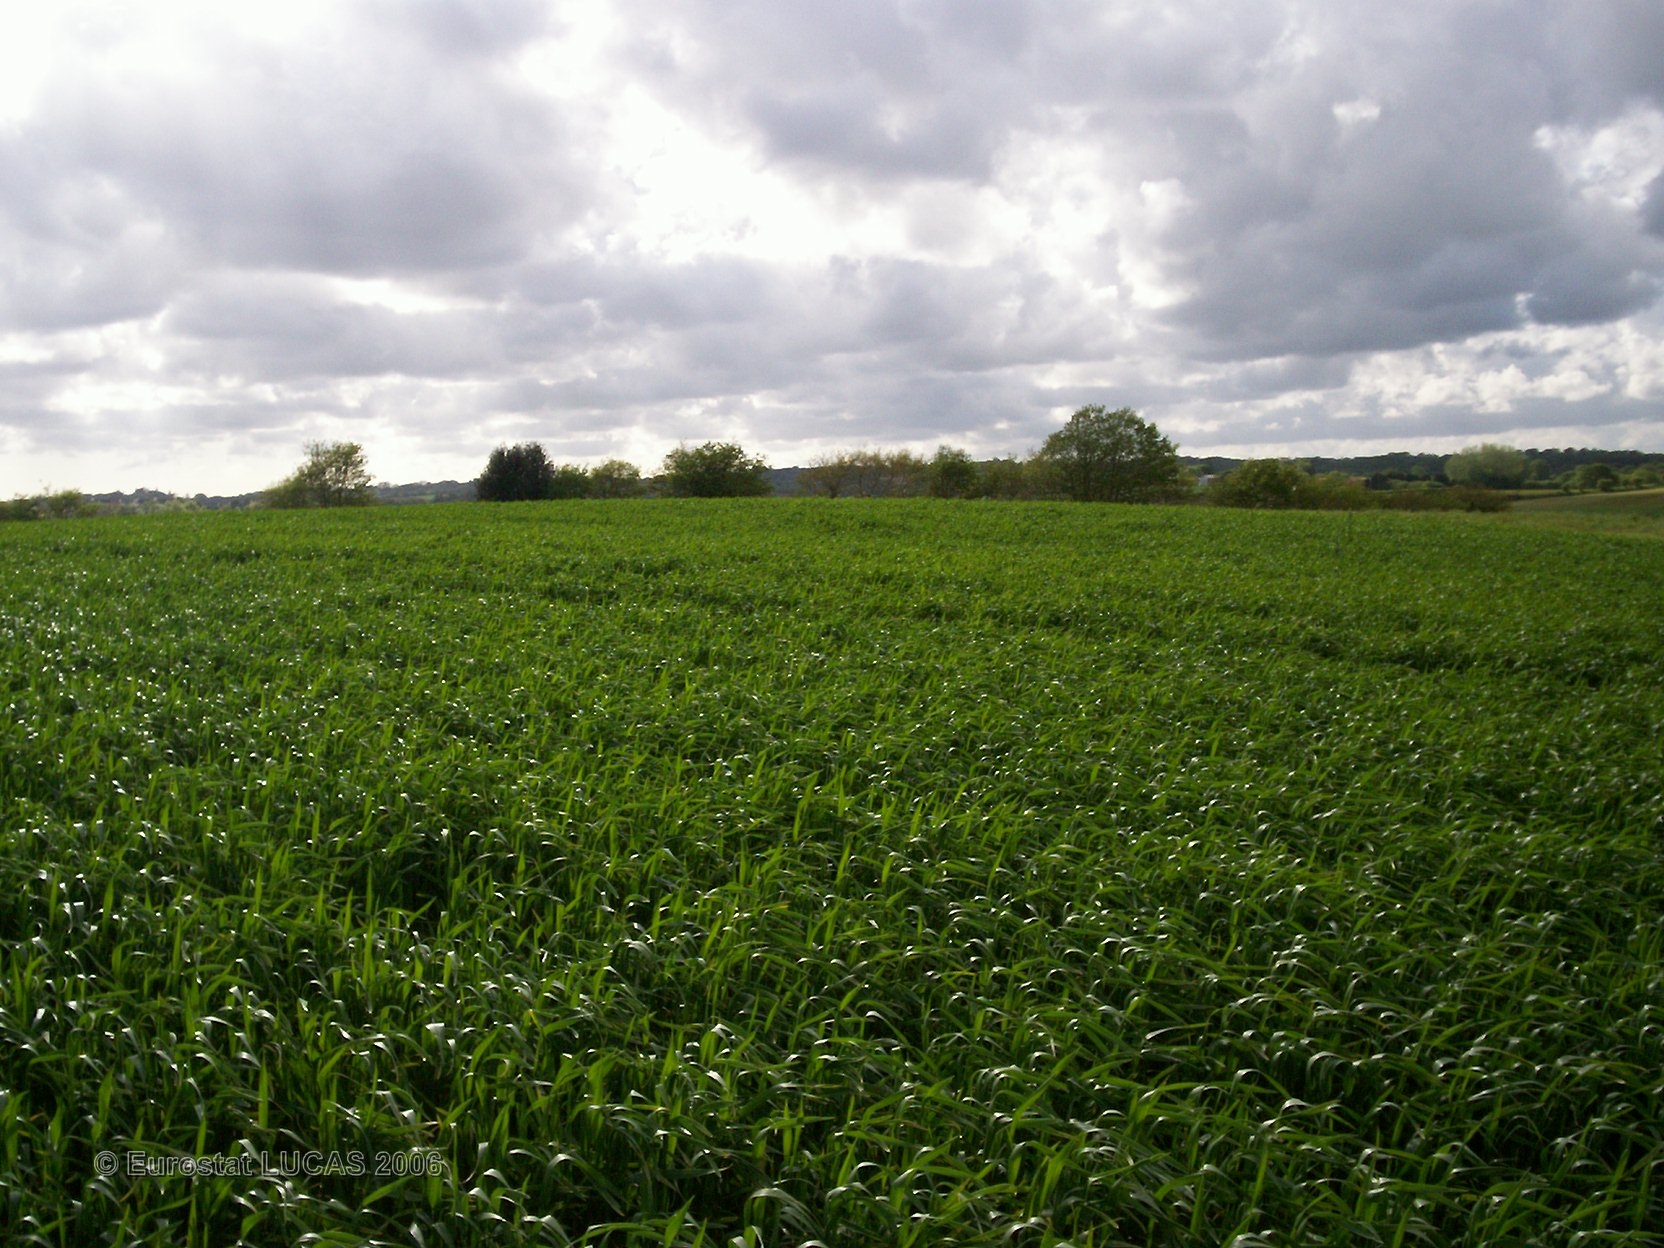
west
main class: Cropland
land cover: Common wheat
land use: Agriculture (excluding fallow land and kitchen gardens)
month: May
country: FR
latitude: 47.9981
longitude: -3.8745
